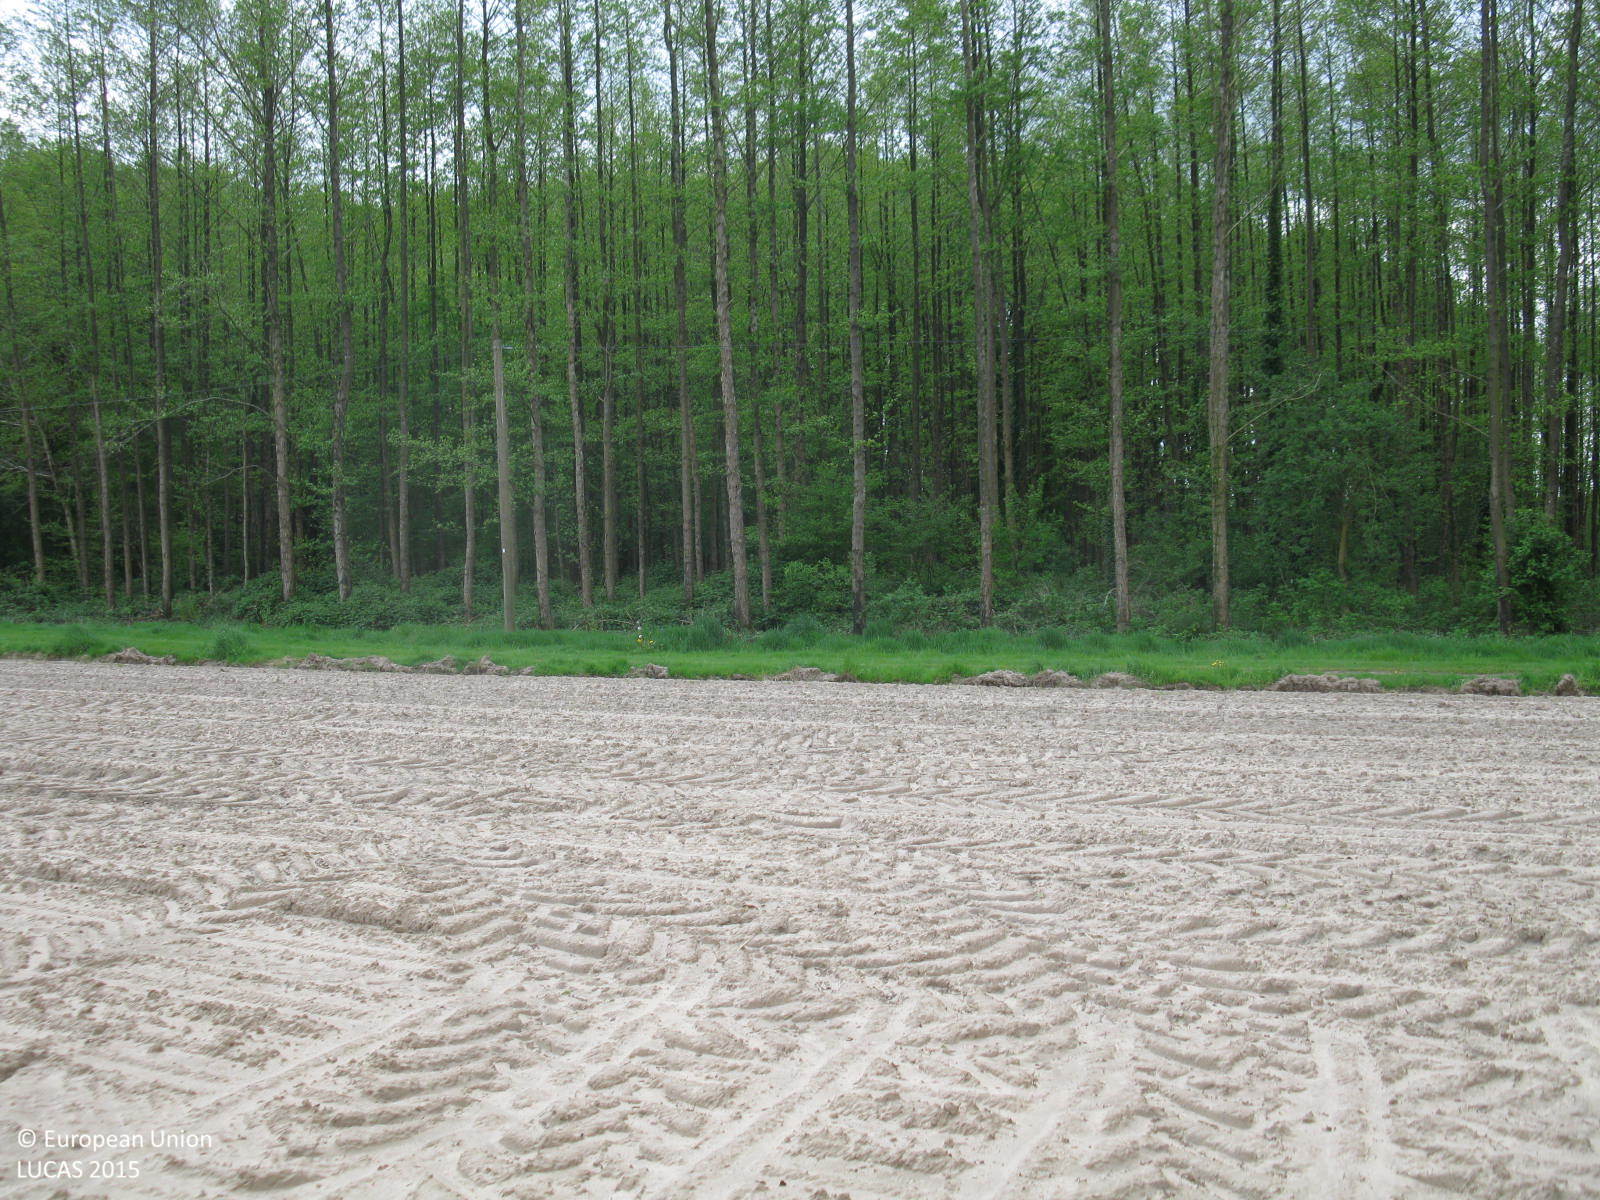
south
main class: Cropland
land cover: Maize
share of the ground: < 10 %
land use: Agriculture (excluding fallow land and kitchen gardens)
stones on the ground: < 10 %
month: May
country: DE
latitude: 52.9225
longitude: 7.3083
